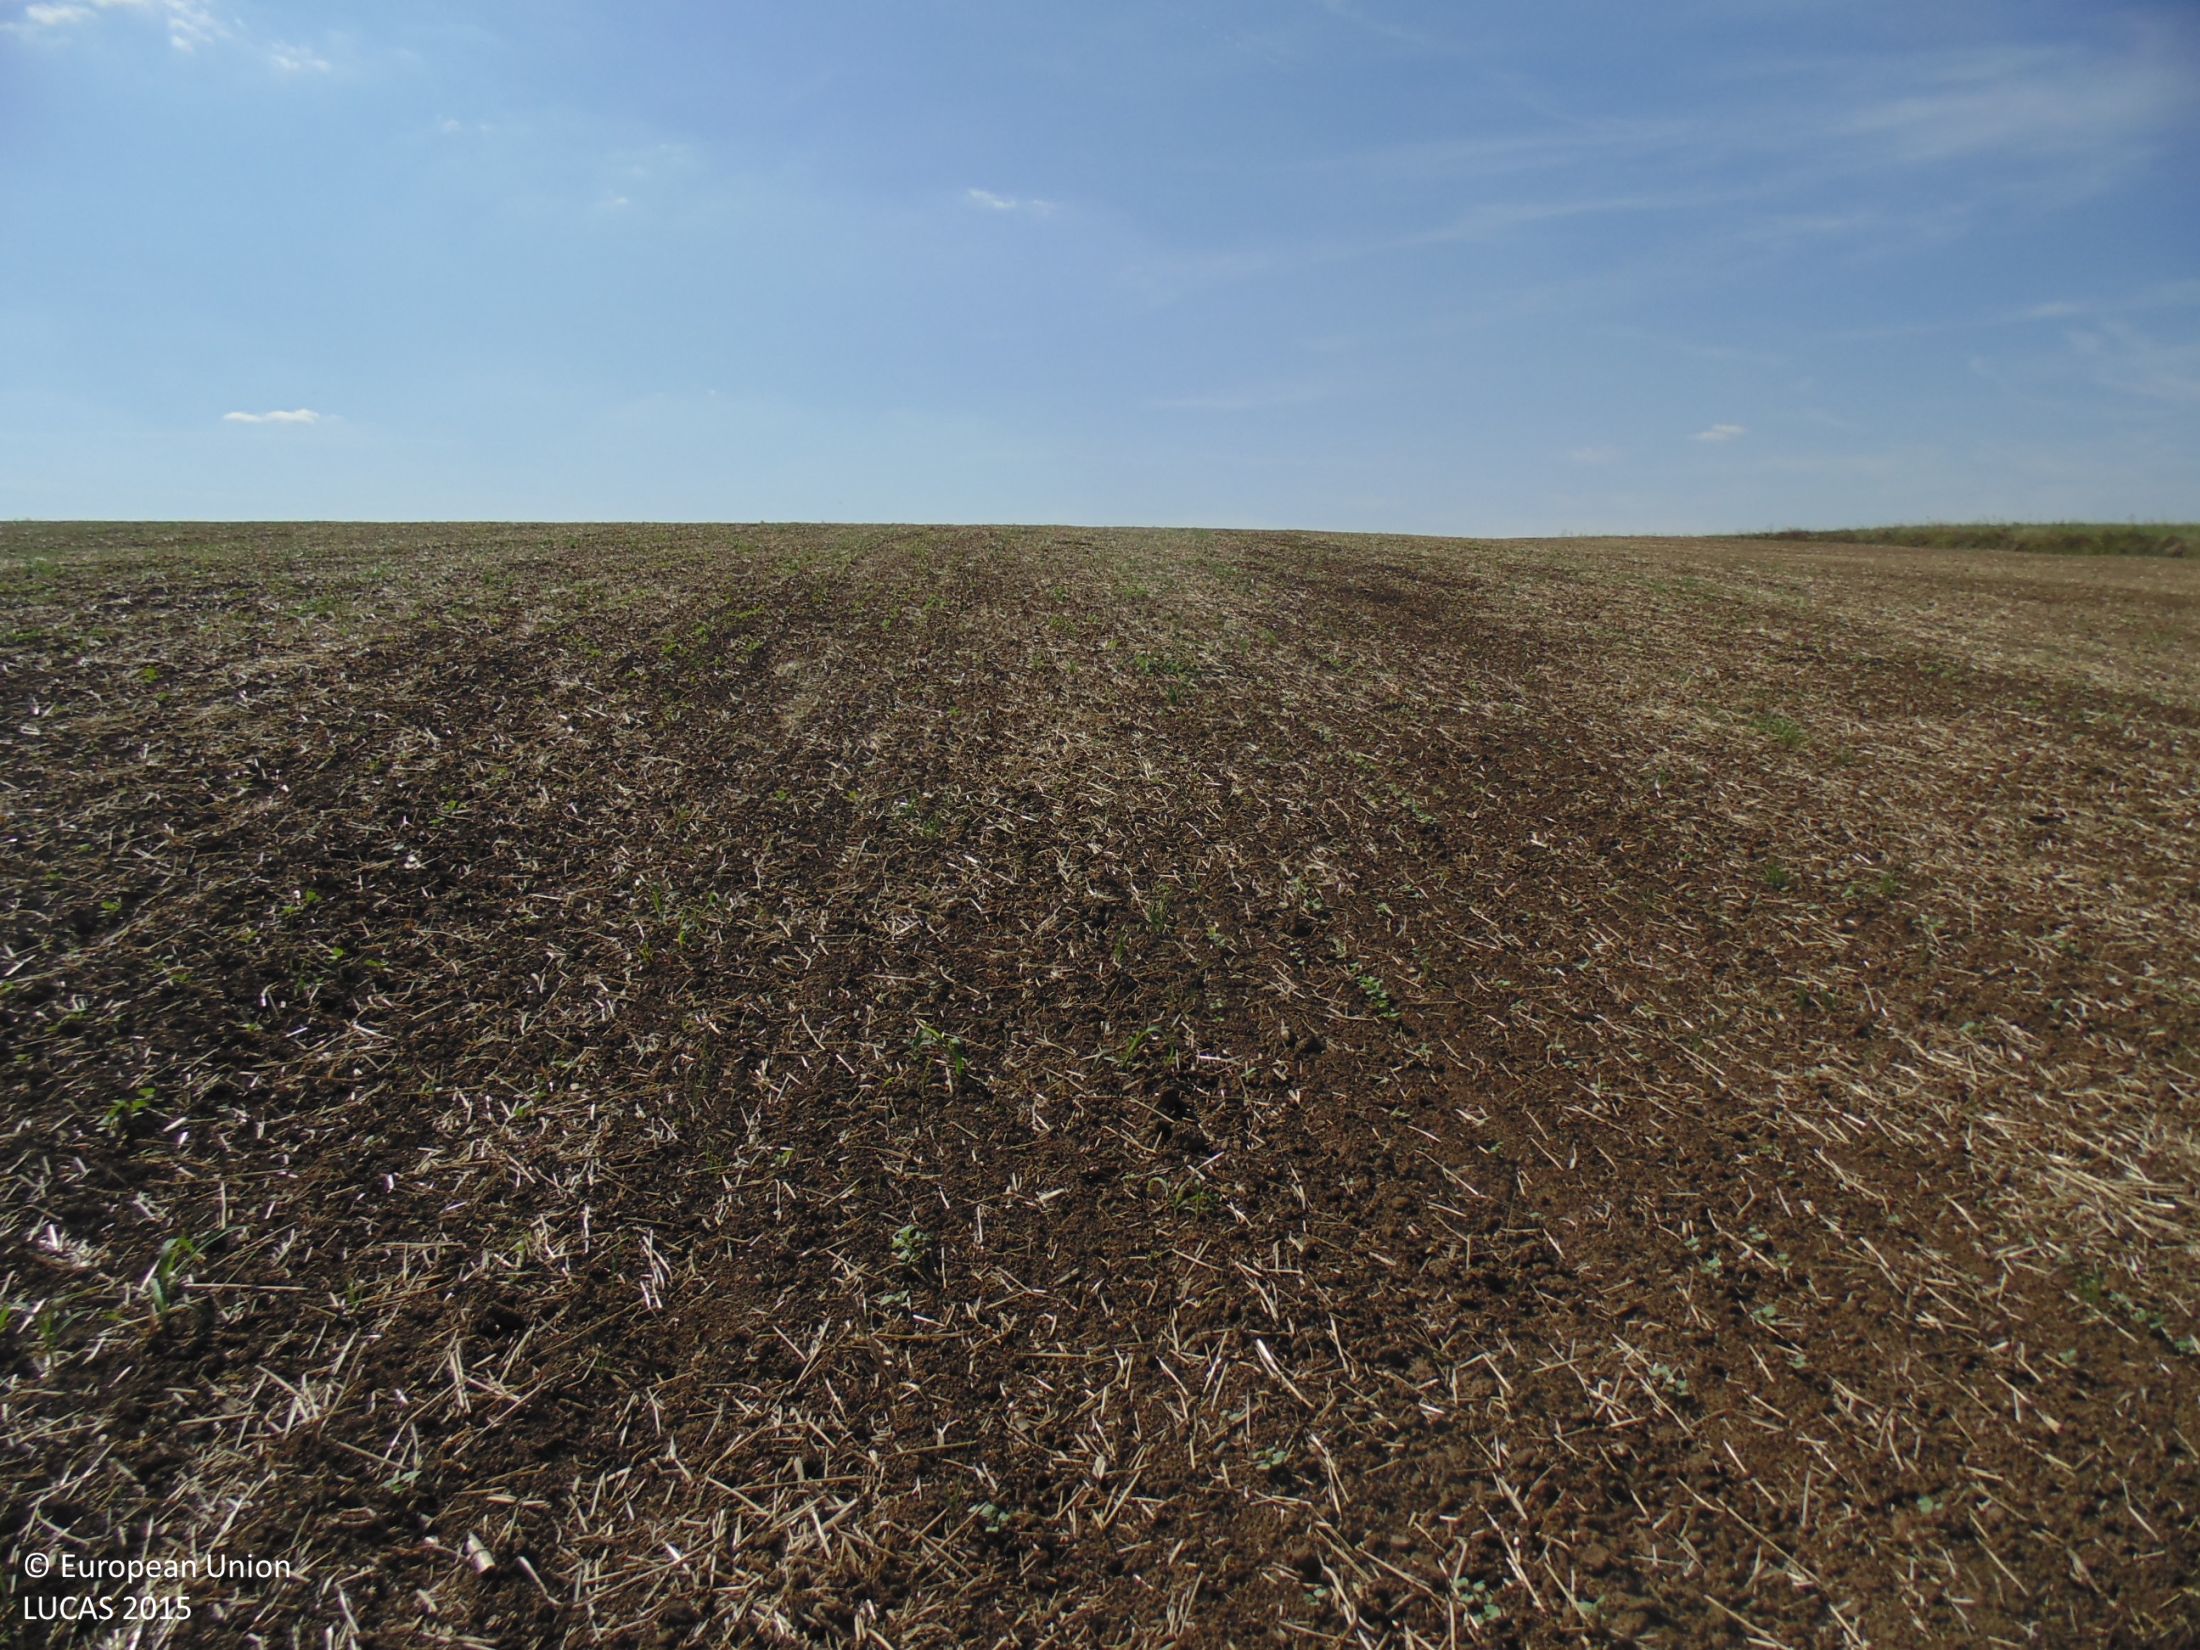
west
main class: Cropland
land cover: Common wheat
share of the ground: < 10 %
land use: Agriculture (excluding fallow land and kitchen gardens)
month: September
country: BG
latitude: 44.0933
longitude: 26.8963
